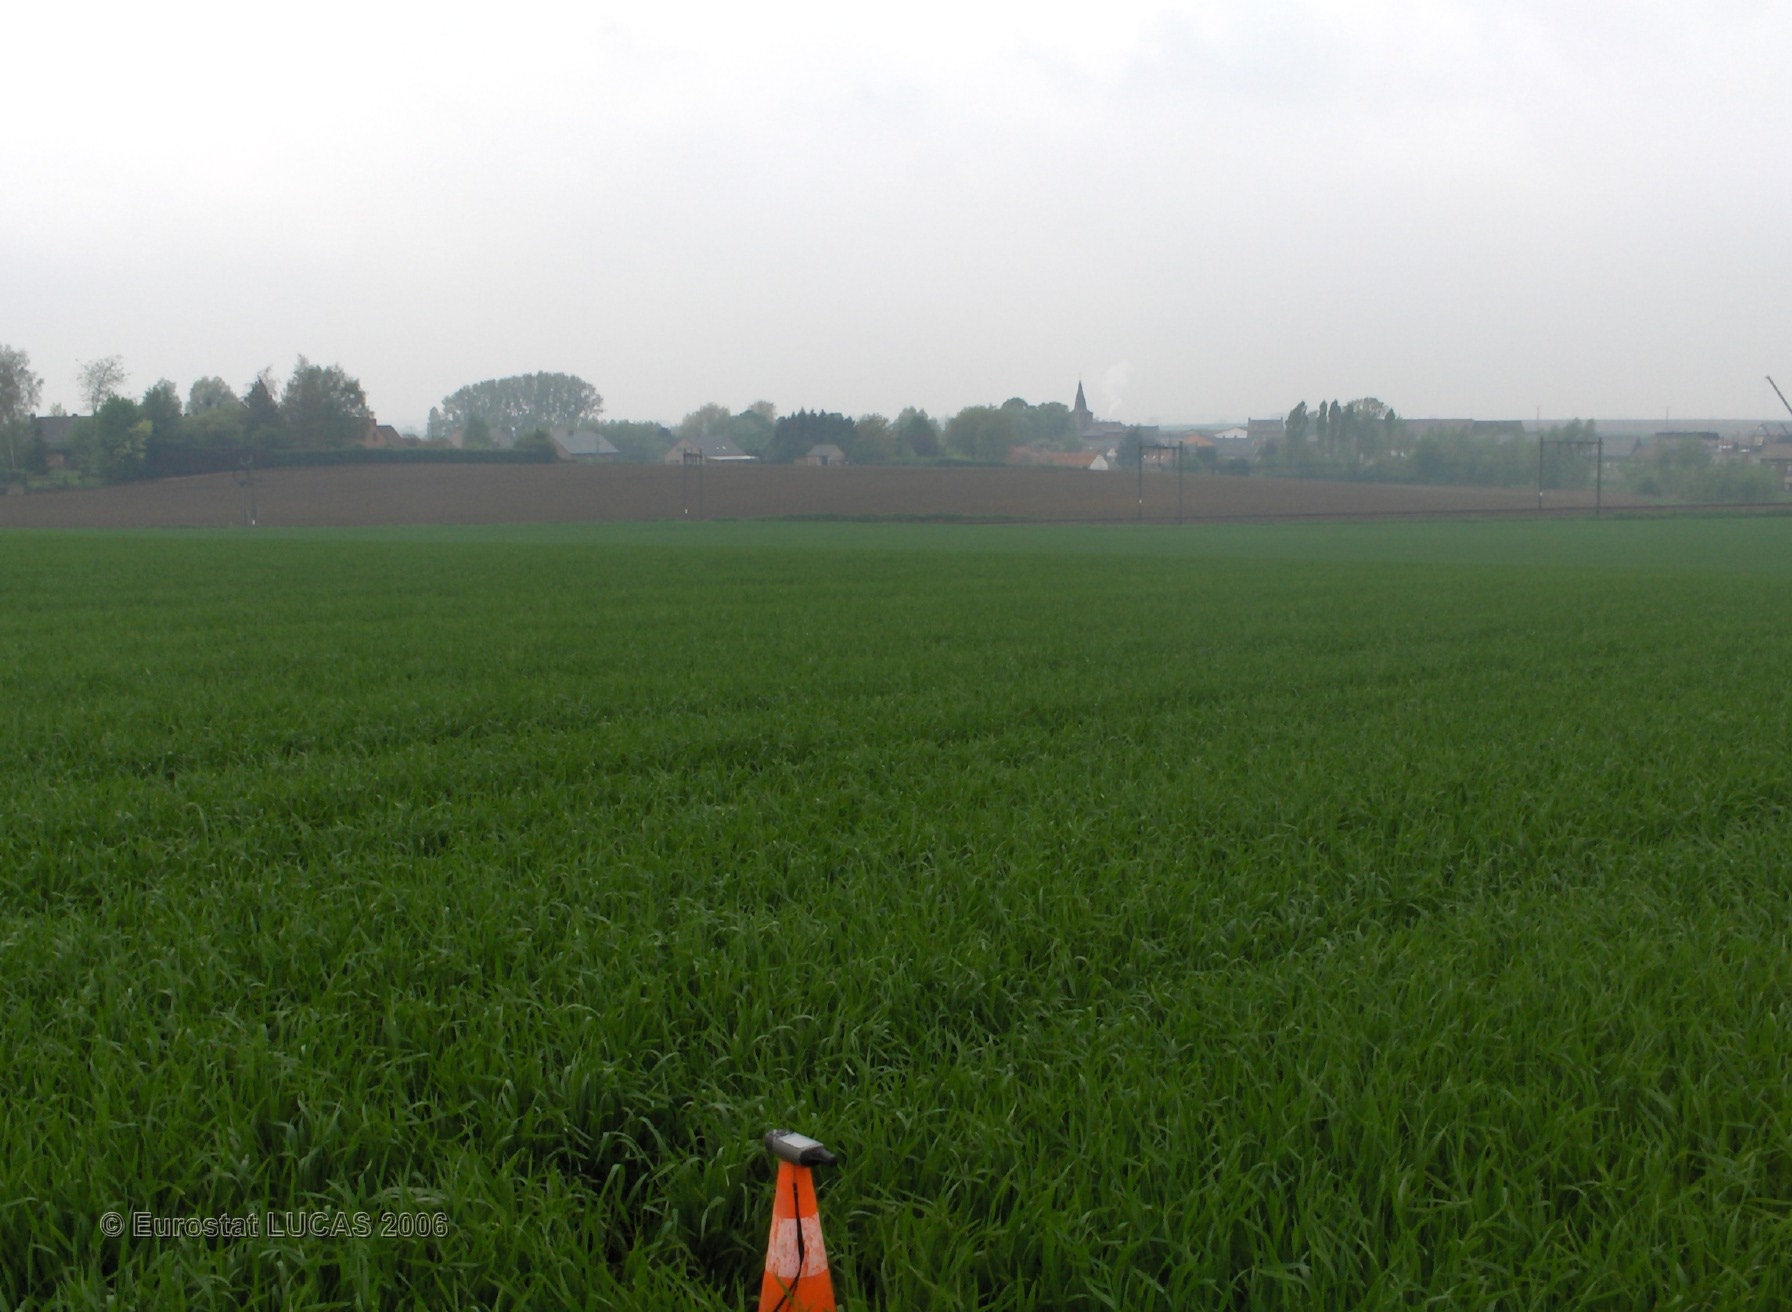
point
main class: Cropland
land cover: Common wheat
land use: Agriculture (excluding fallow land and kitchen gardens)
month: May
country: BE
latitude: 50.5233
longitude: 4.5655
